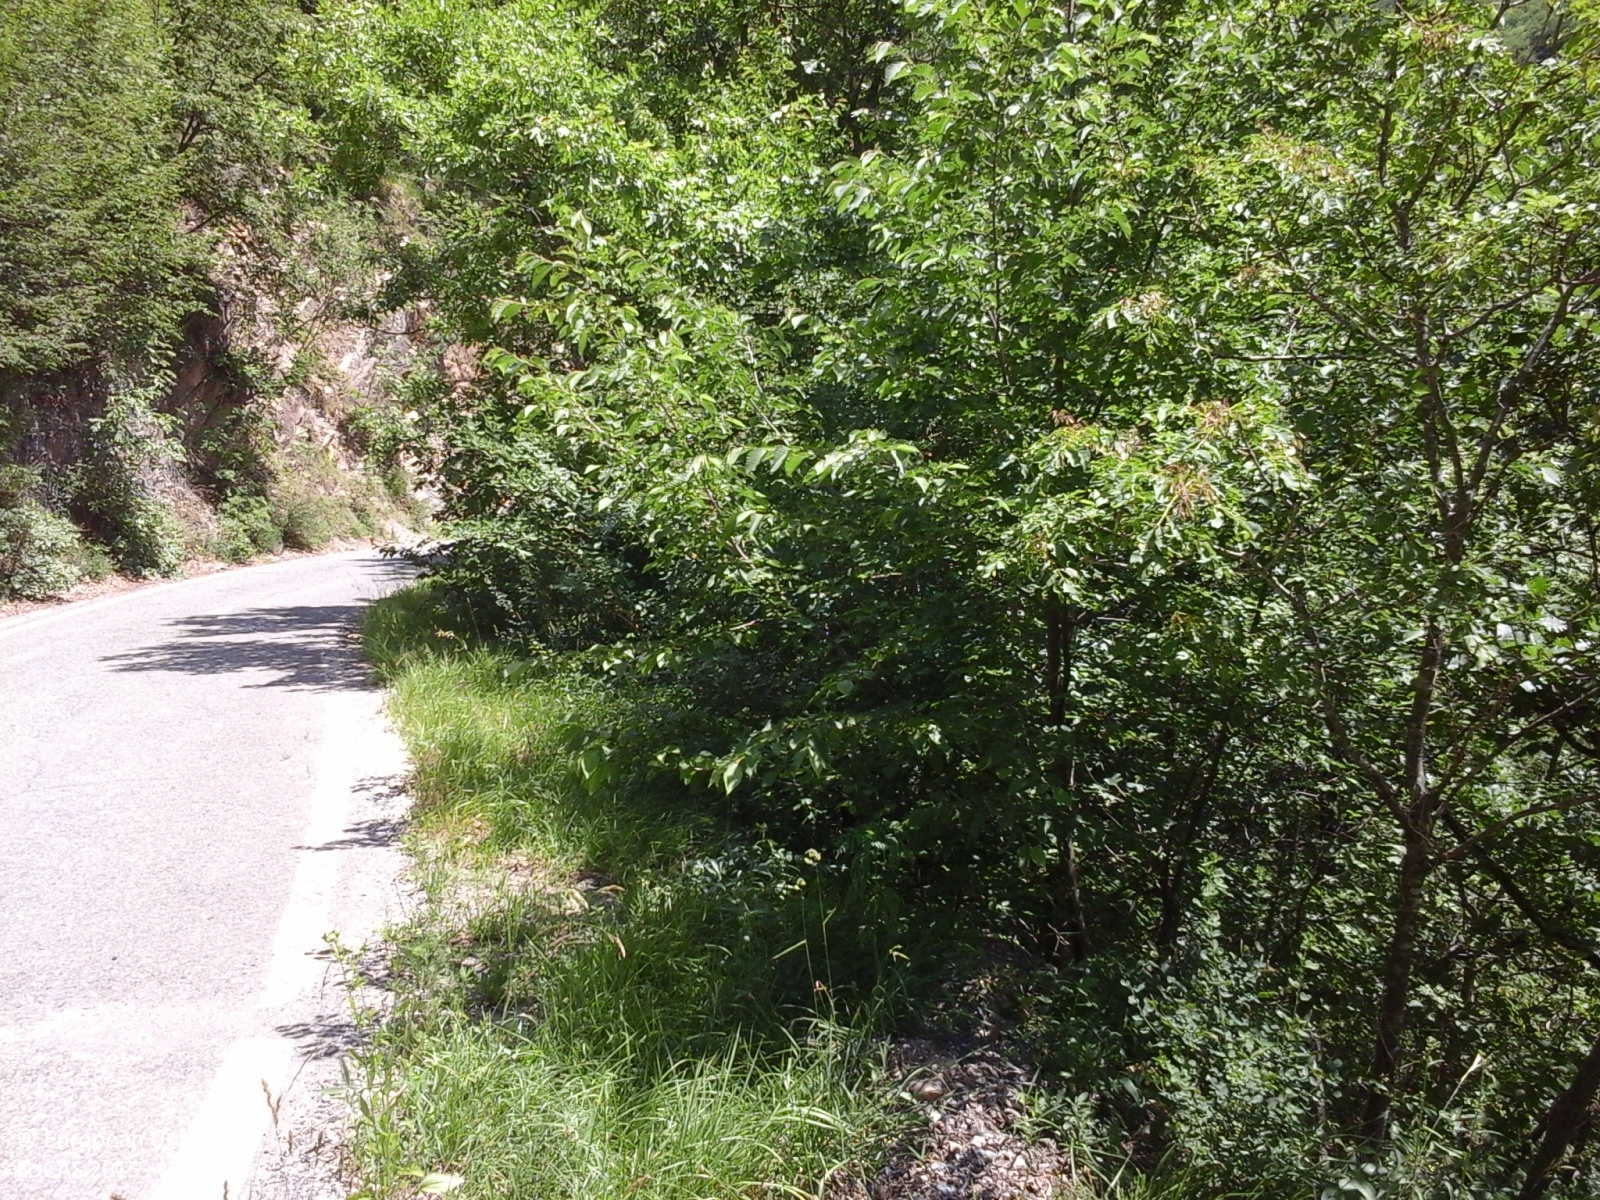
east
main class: Woodland
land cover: Broadleaved woodland
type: thermophilous deciduous forest
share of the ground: > 75 %
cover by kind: broadleaved forest trees 90 %, shrubs 5 %, herbaceous plants 5 %
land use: Forestry
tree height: > 5 m
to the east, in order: Broadleaved woodland; Electric lines; Paved roads, cycling and walking lanes; Electric lines; Broadleaved woodland; Inland fresh running water; Paved roads, cycling and walking lanes; Broadleaved woodland; Inland fresh running water; Broadleaved woodland
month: June
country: IT
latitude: 44.6357
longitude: 9.1572
